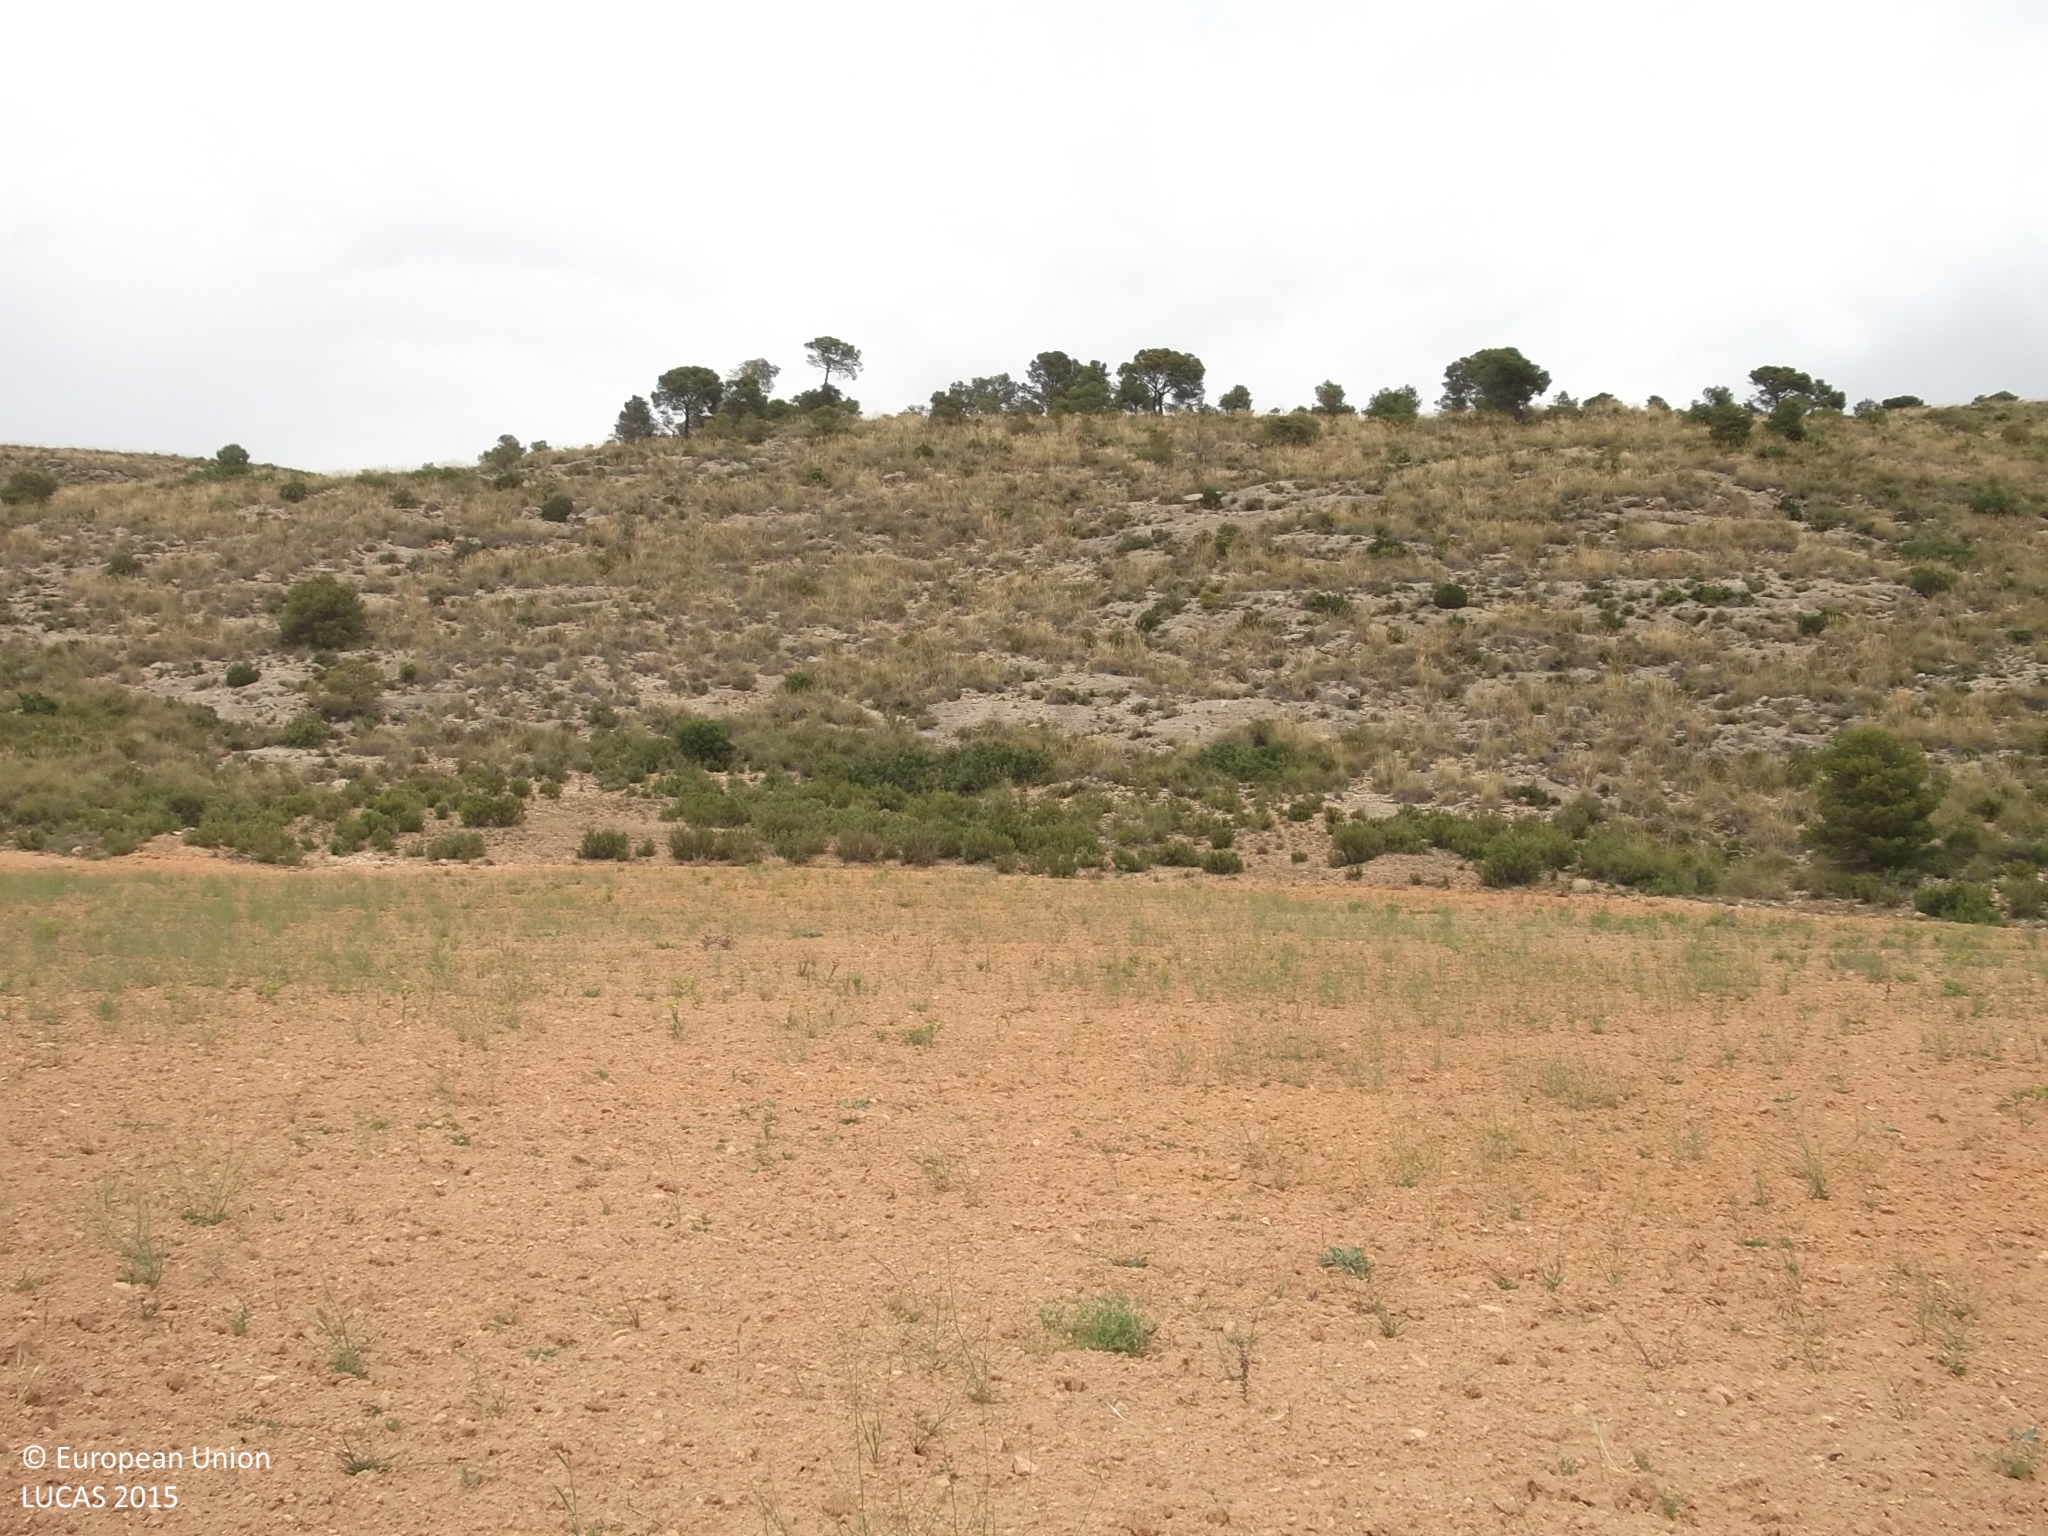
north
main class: Grassland
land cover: Spontaneously vegetated surfaces
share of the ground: 25 - 50 %
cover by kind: unconsolidated bare surface 70 %, herbaceous plants 30 %
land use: Fallow land
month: May
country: ES
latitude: 38.4811
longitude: -1.4434
